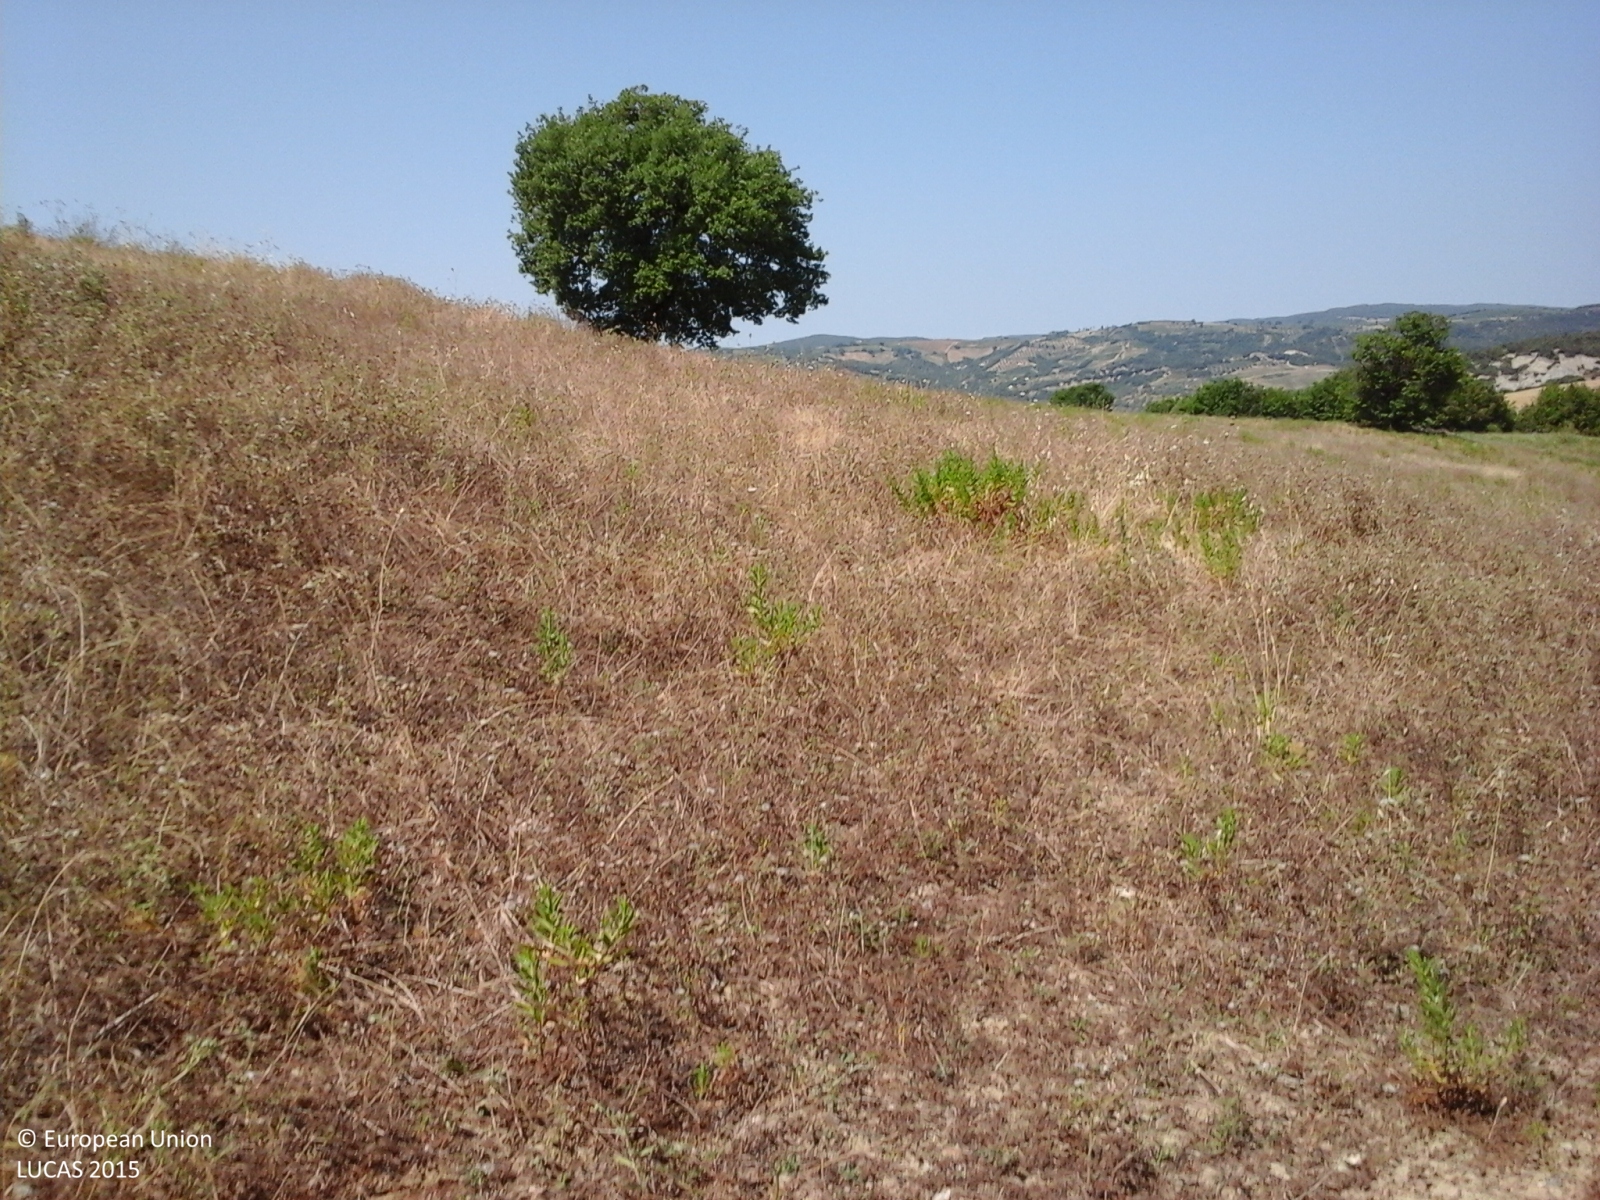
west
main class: Grassland
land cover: Grassland without tree/shrub cover
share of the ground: 50 - 75 %
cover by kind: herbaceous plants 95 %, unconsolidated bare surface 5 %
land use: Agriculture (excluding fallow land and kitchen gardens)
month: July
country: IT
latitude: 42.9849
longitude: 11.5771
